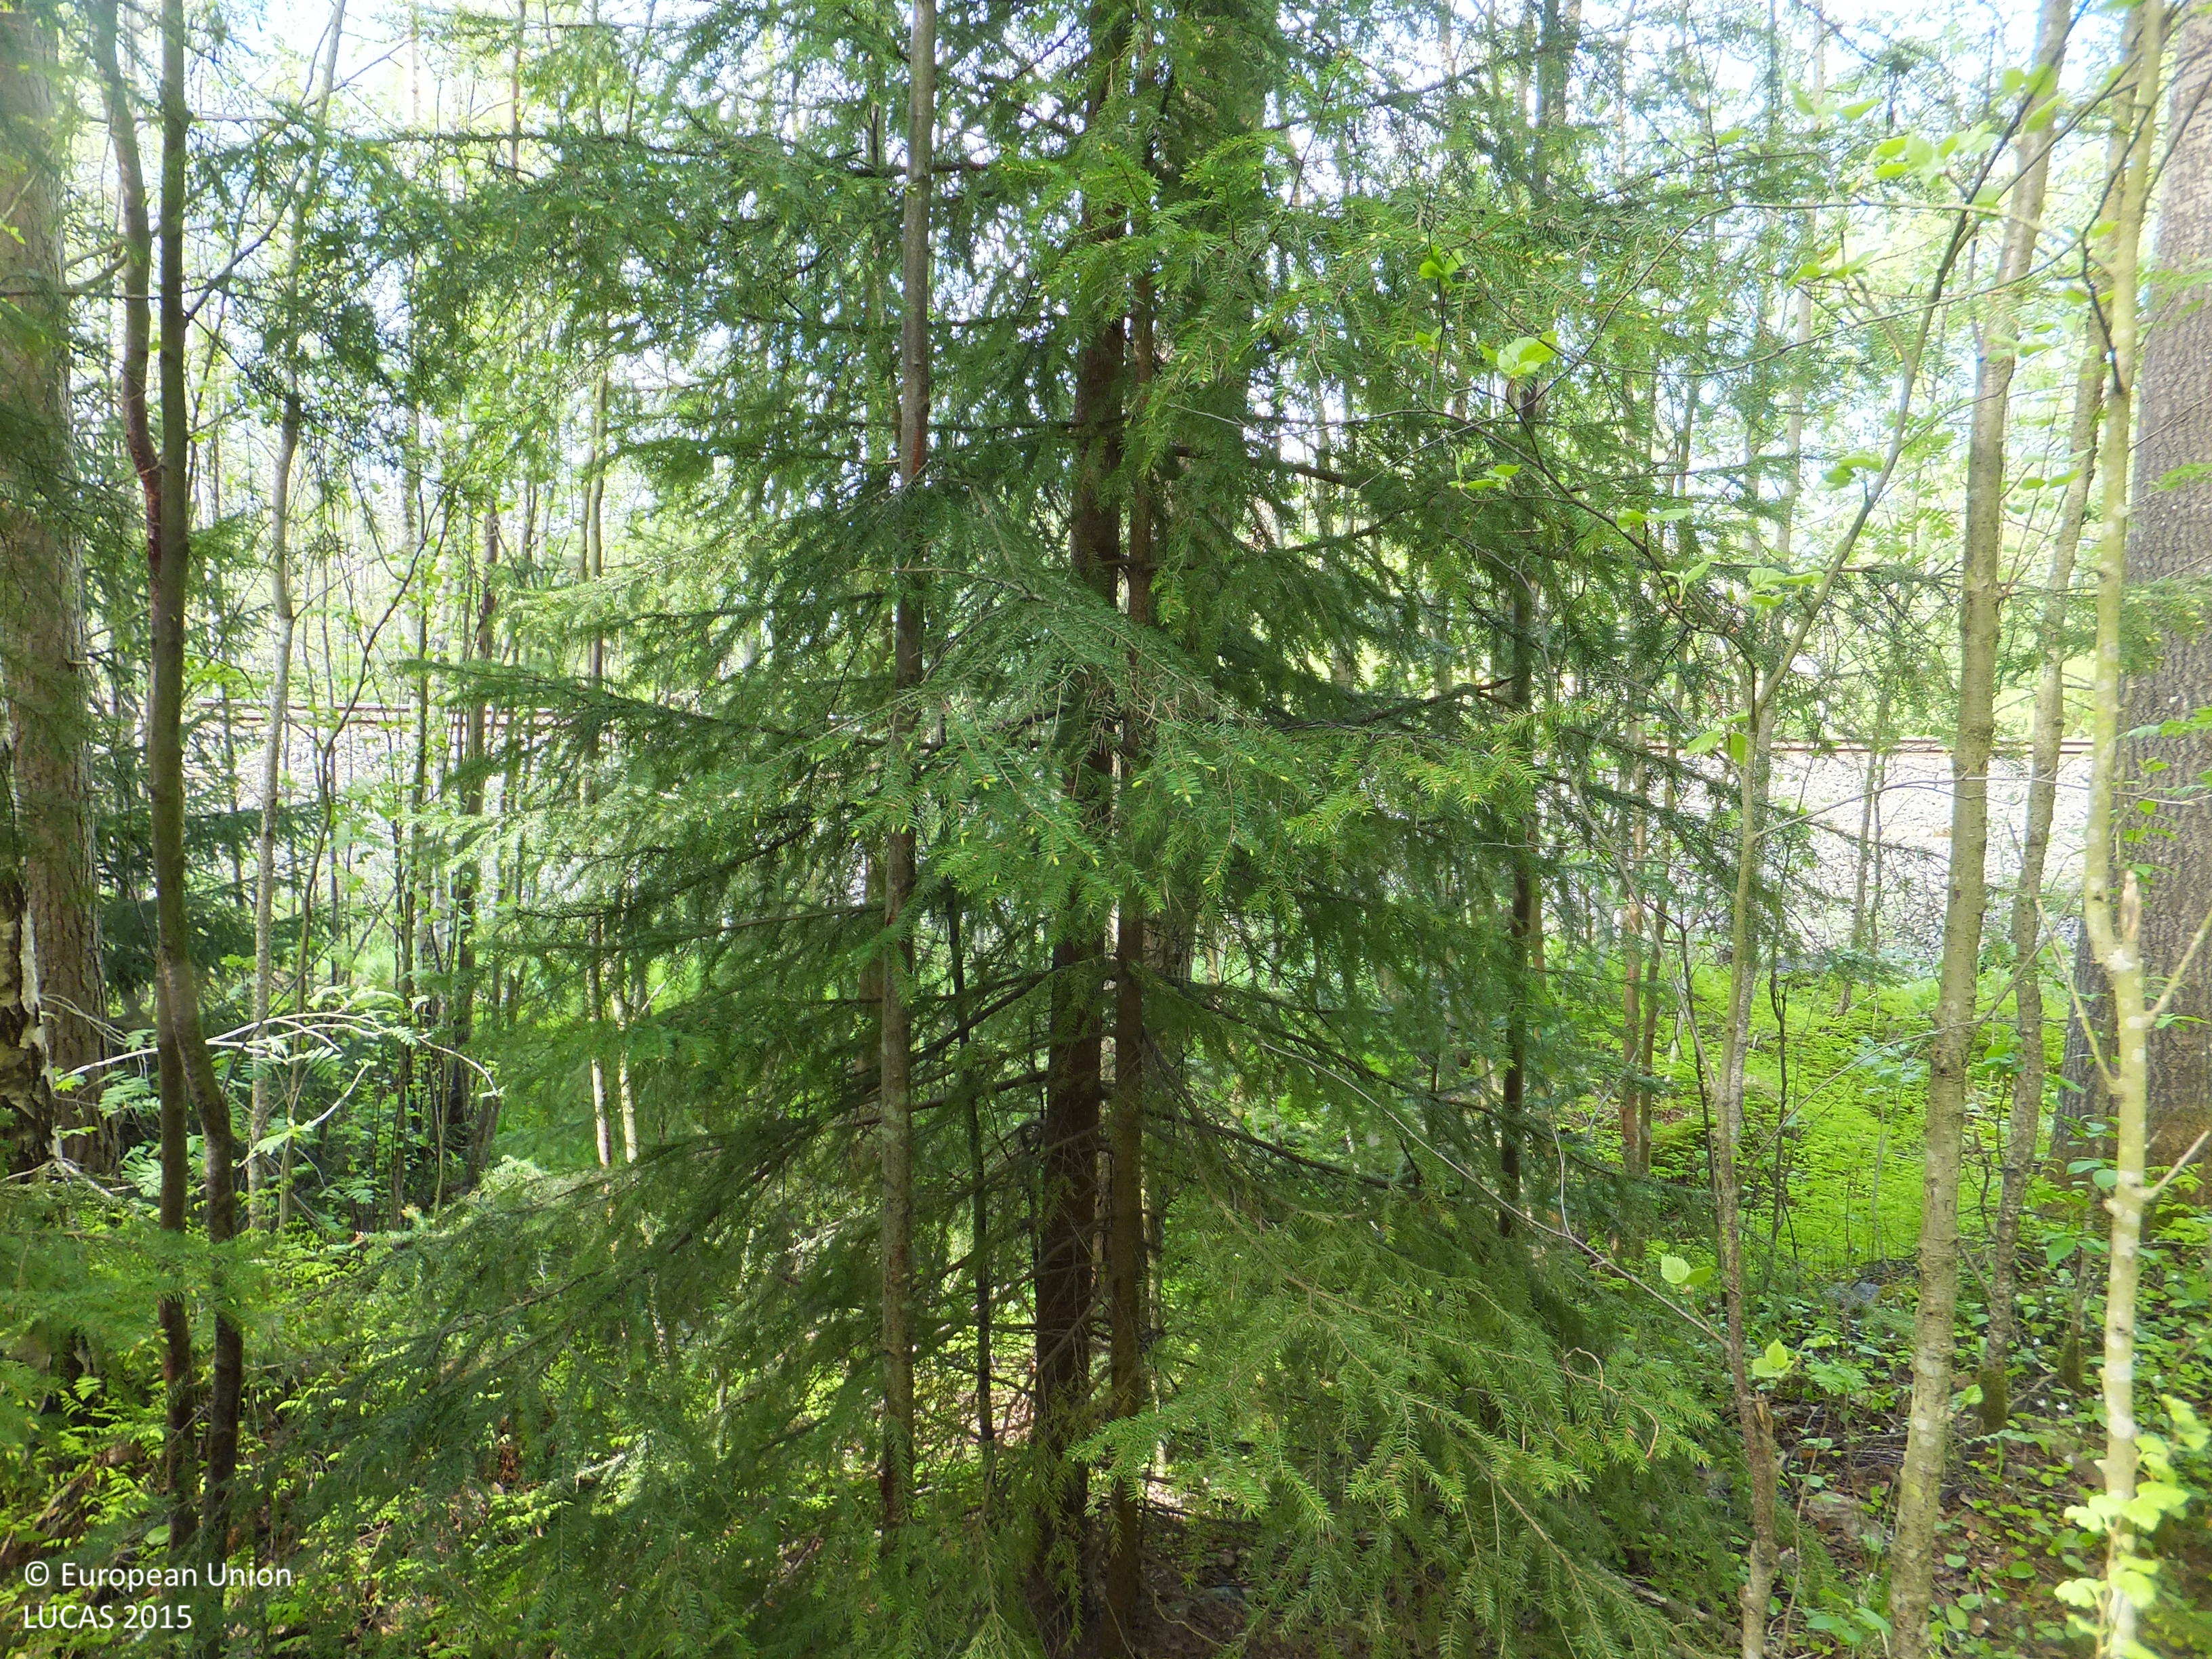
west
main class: Woodland
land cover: Other mixed woodland
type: boreal forest
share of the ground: > 75 %
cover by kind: broadleaved forest trees 70 %, coniferous forest trees 30 %
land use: Semi-natural and natural areas not in use
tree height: > 5 m
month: May
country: FI
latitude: 63.6643
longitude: 22.7165
